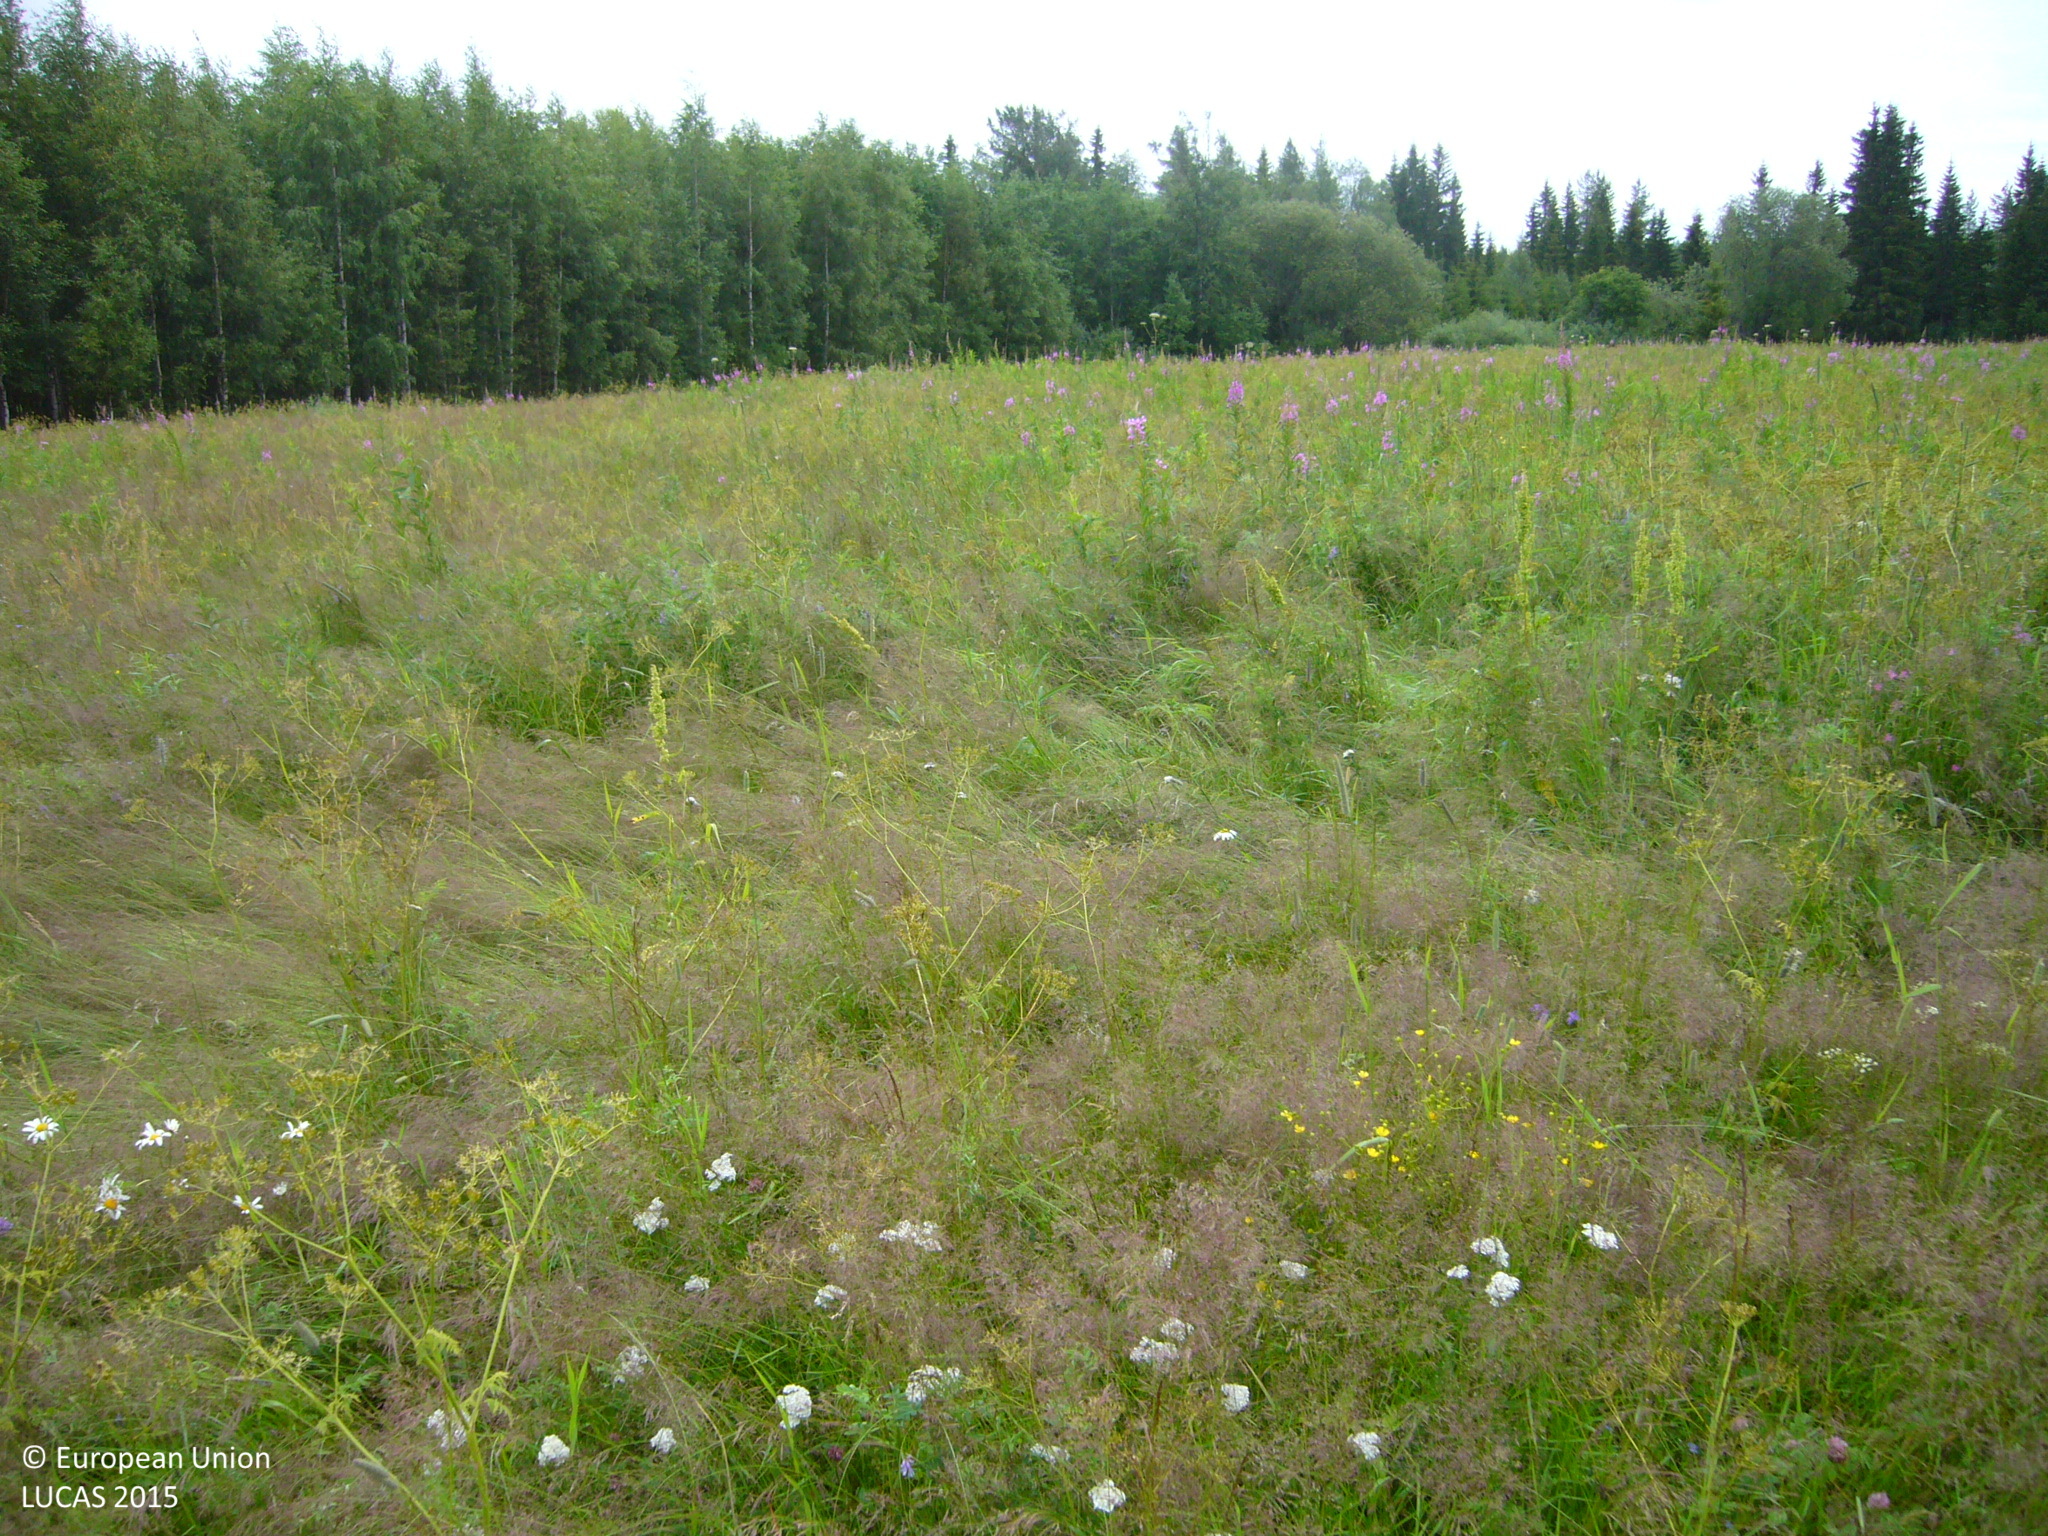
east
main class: Grassland
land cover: Spontaneously vegetated surfaces
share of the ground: > 75 %
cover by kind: herbaceous plants 100 %
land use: Fallow land
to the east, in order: Spontaneously vegetated surfaces; Ditches and canals; Broadleaved woodland; Other mixed woodland; Pine dominated mixed woodland; Spruce dominated mixed woodland; Spruce dominated coniferous woodland; Tracks; Spruce dominated coniferous woodland
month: July
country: FI
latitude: 63.9726
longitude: 26.6496
